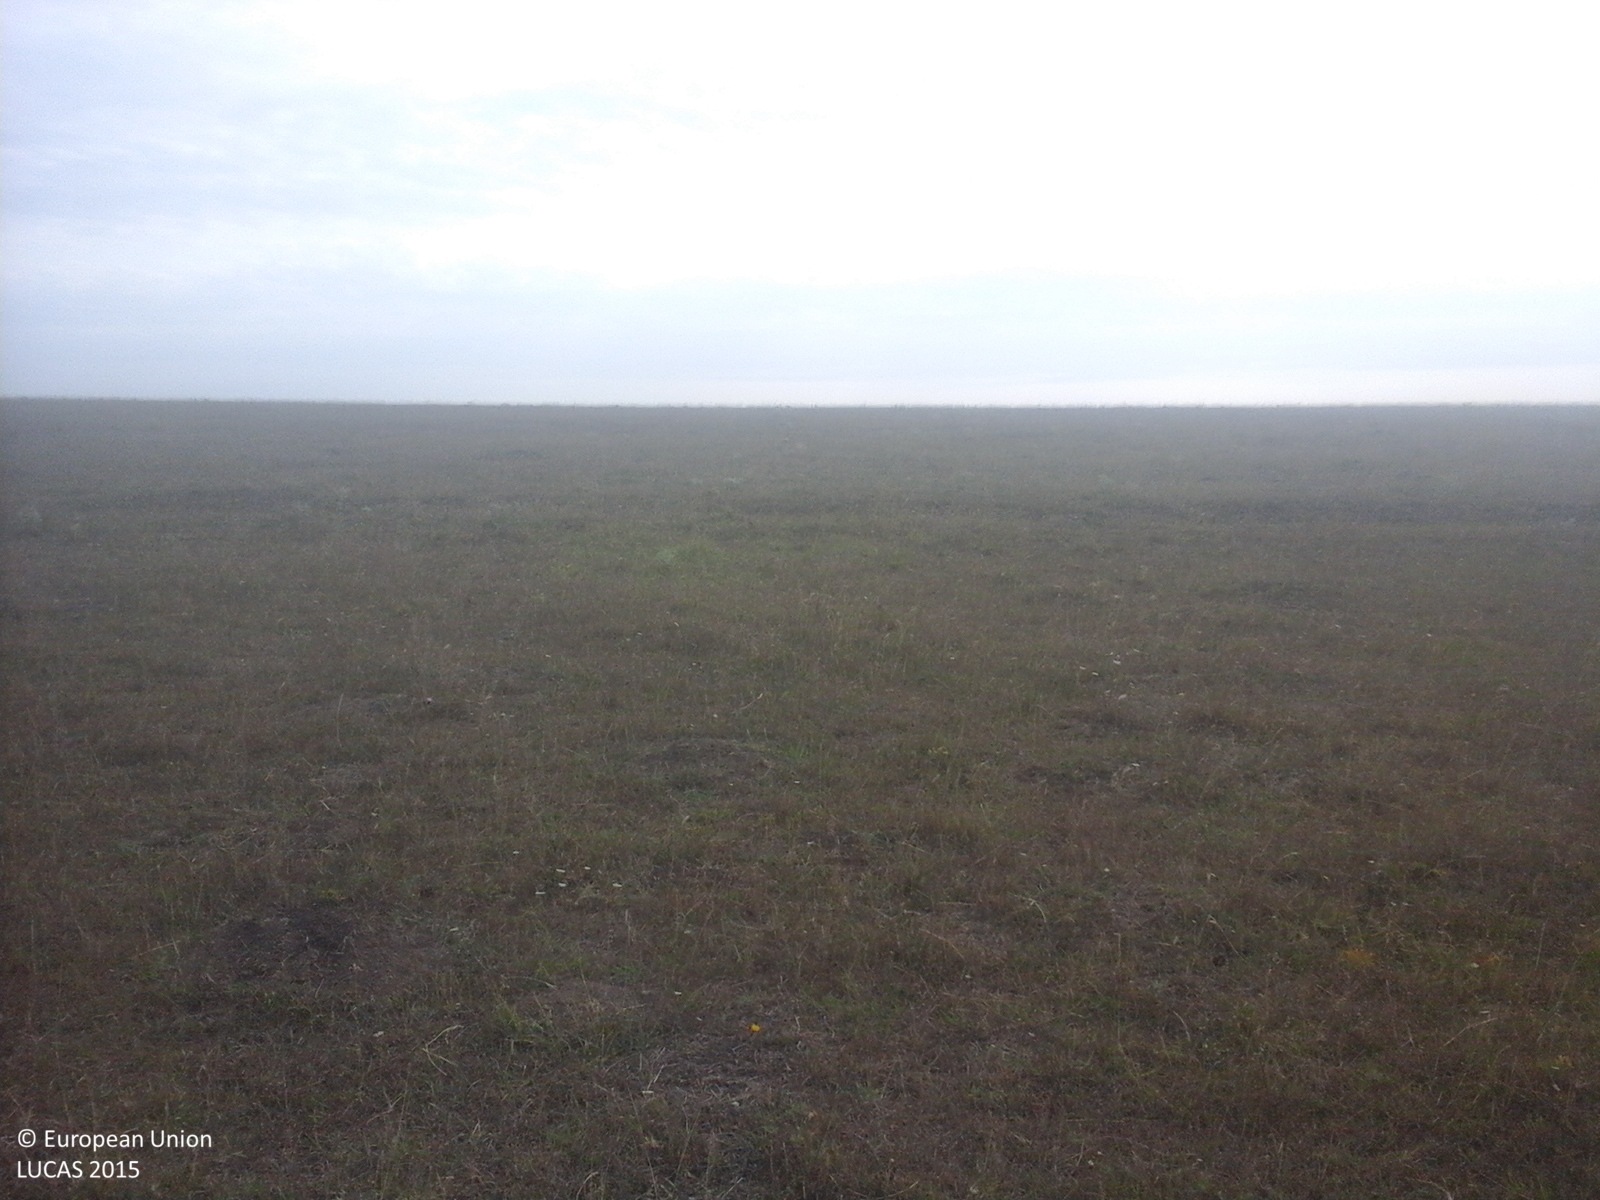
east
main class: Grassland
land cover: Grassland without tree/shrub cover
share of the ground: > 75 %
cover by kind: herbaceous plants 100 %
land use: Agriculture (excluding fallow land and kitchen gardens)
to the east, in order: Grassland without tree/shrub cover
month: August
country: RO
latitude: 43.9710
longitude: 28.1426
